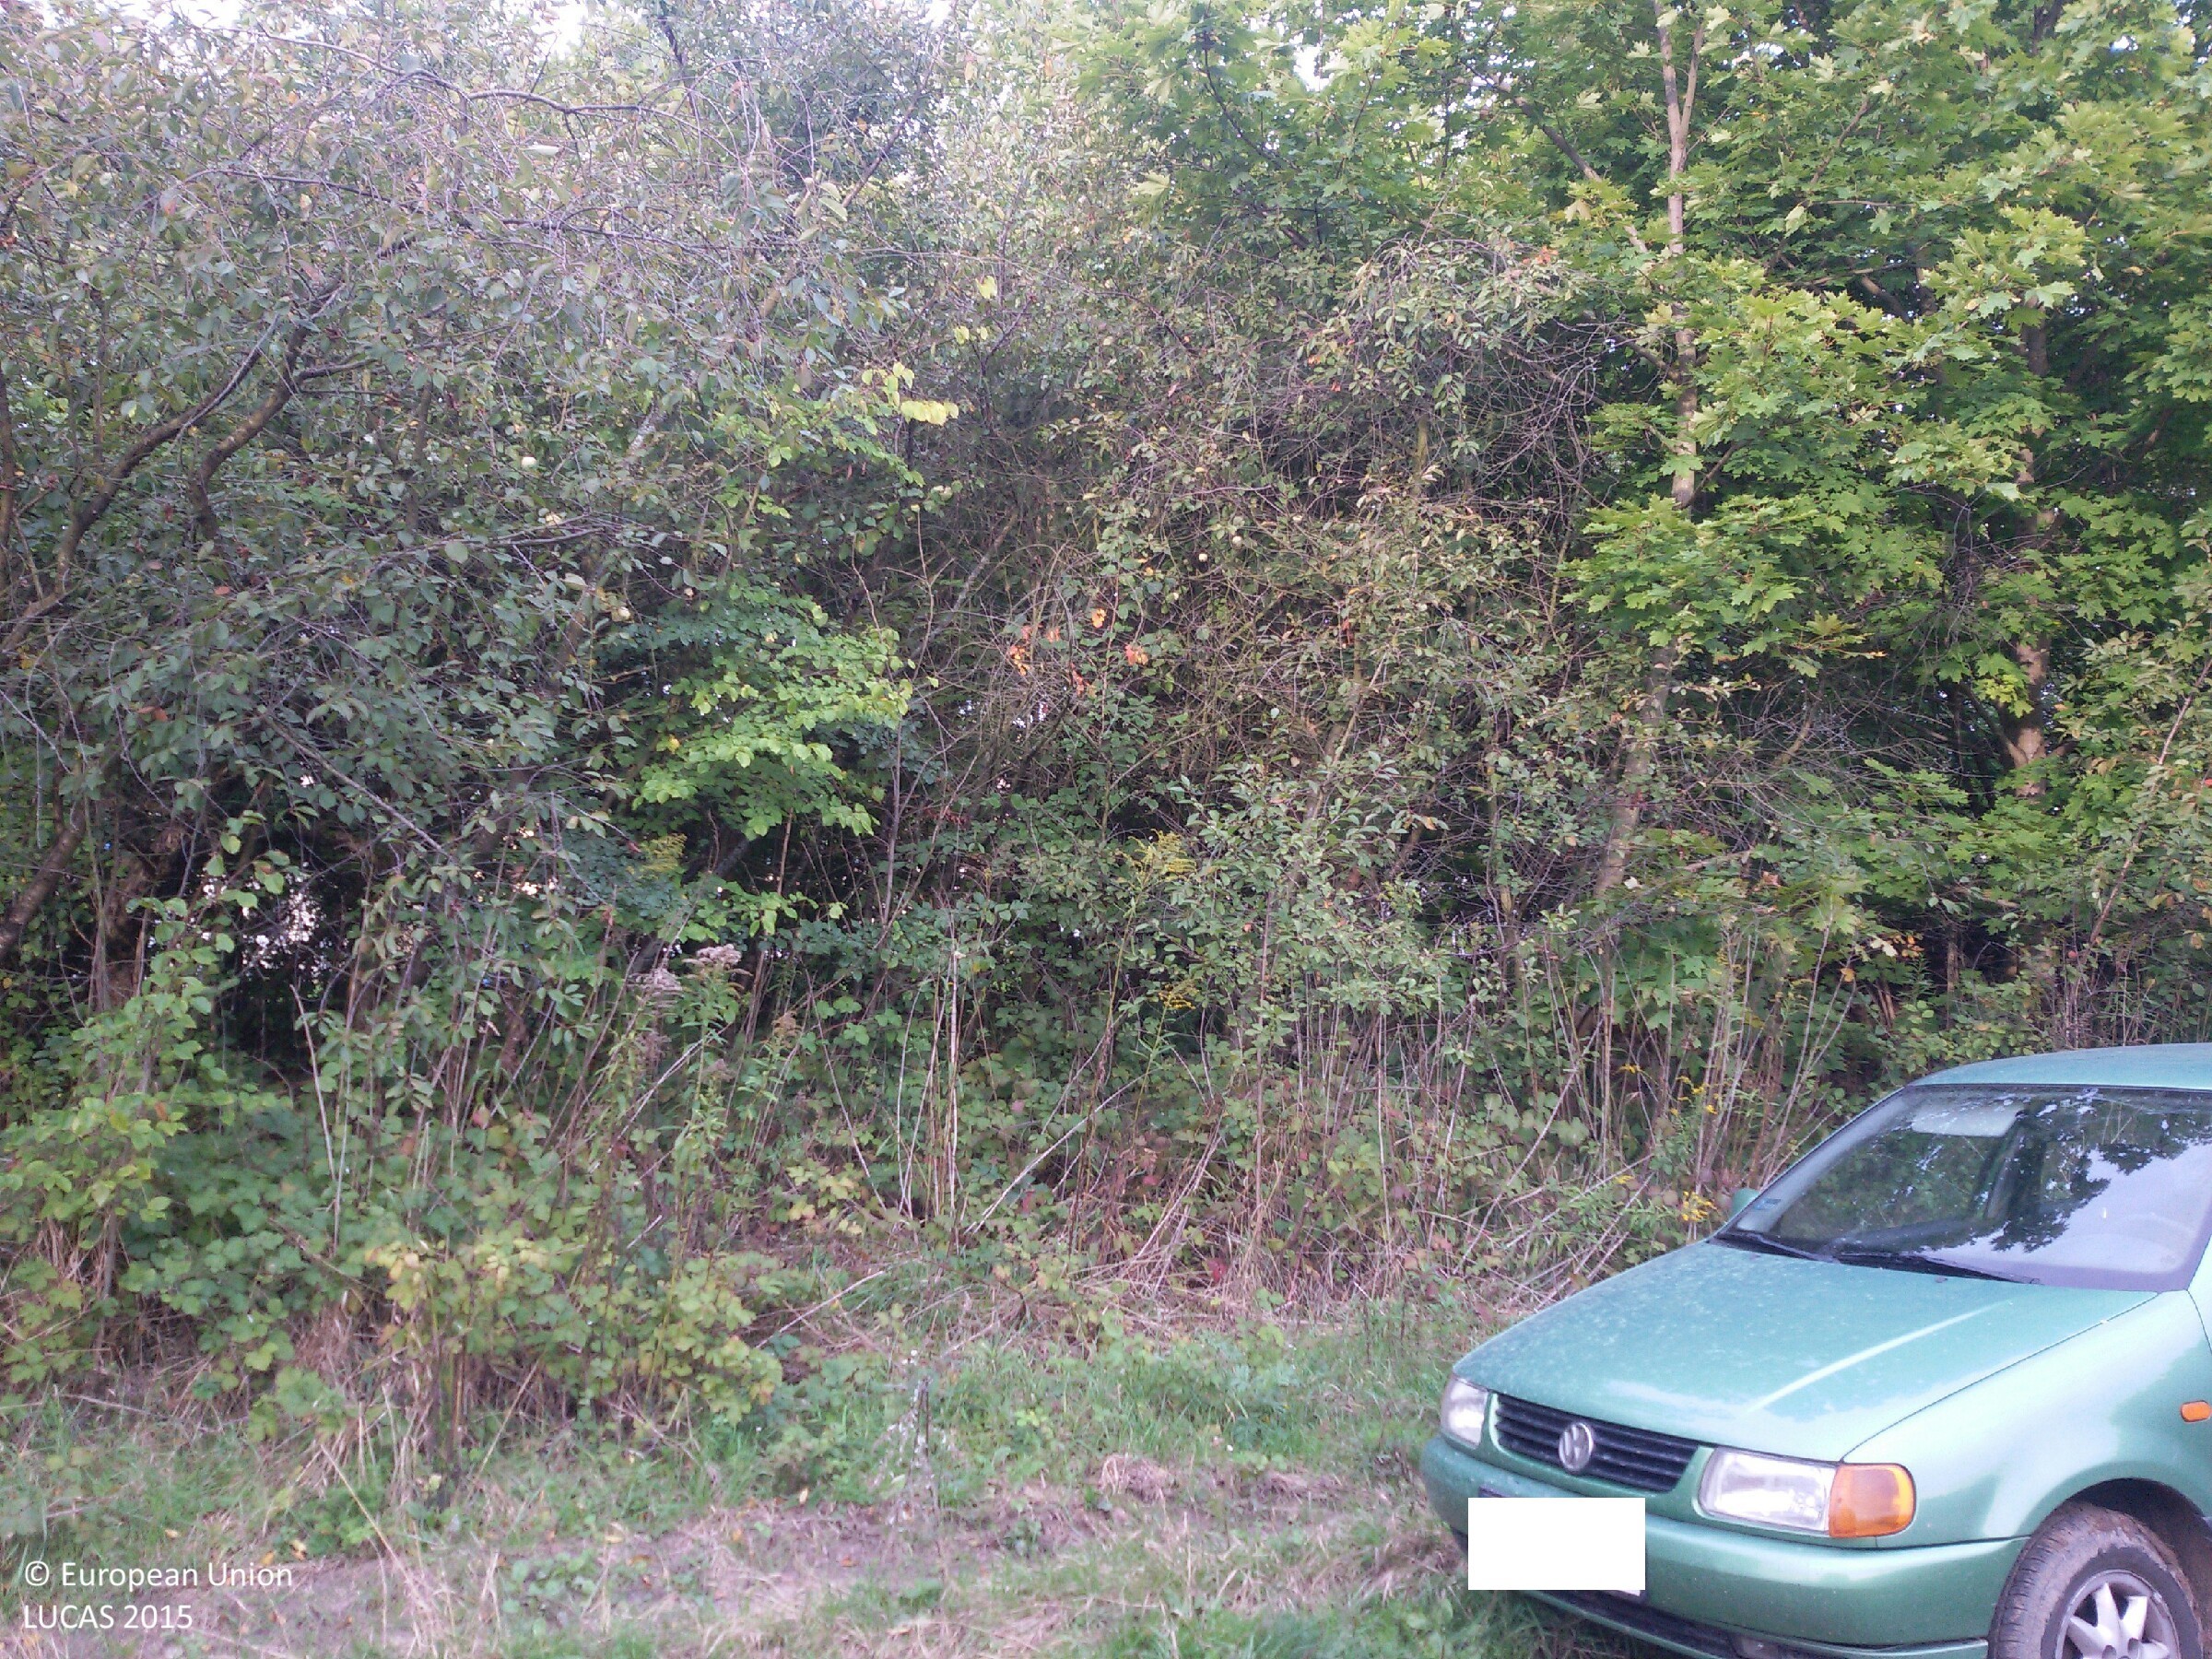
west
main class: Cropland
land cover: Triticale
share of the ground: 10 - 25 %
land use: Agriculture (excluding fallow land and kitchen gardens)
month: September
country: PL
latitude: 54.2128
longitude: 19.3938
